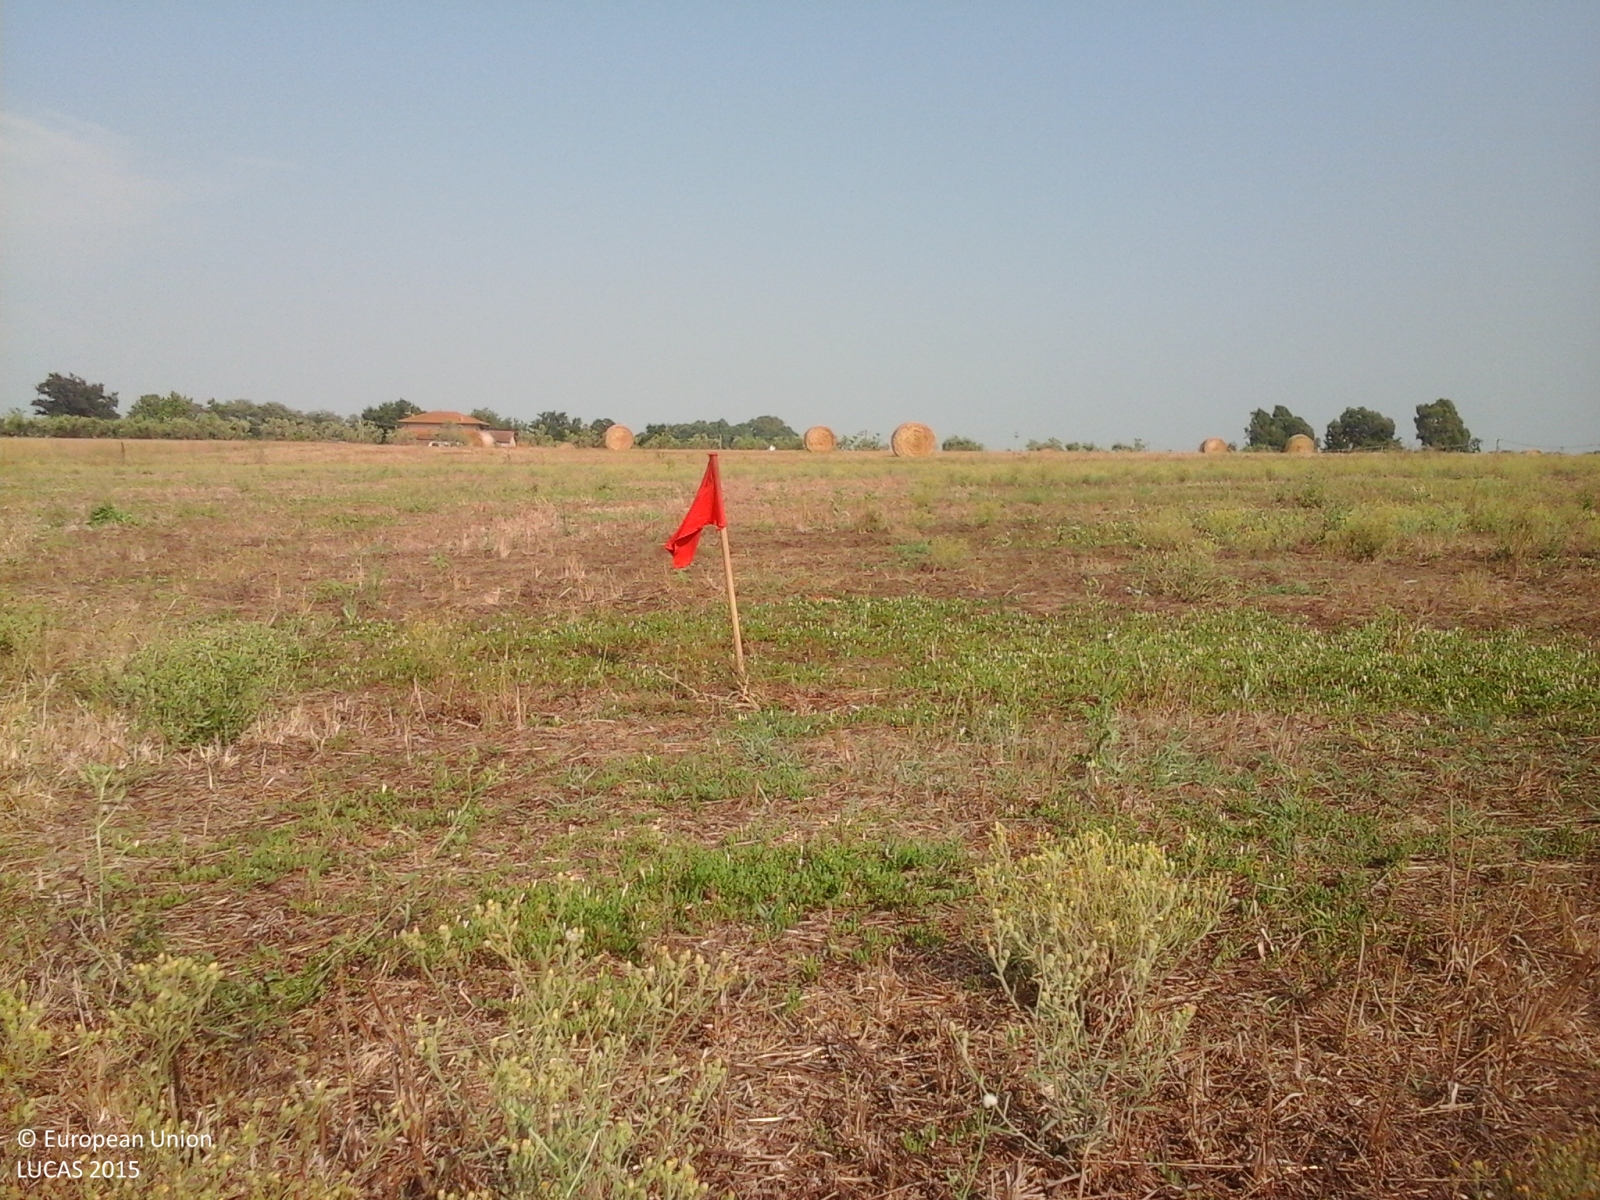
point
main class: Cropland
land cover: Durum wheat
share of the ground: > 75 %
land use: Agriculture (excluding fallow land and kitchen gardens)
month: July
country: IT
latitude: 41.4950
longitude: 12.7799
